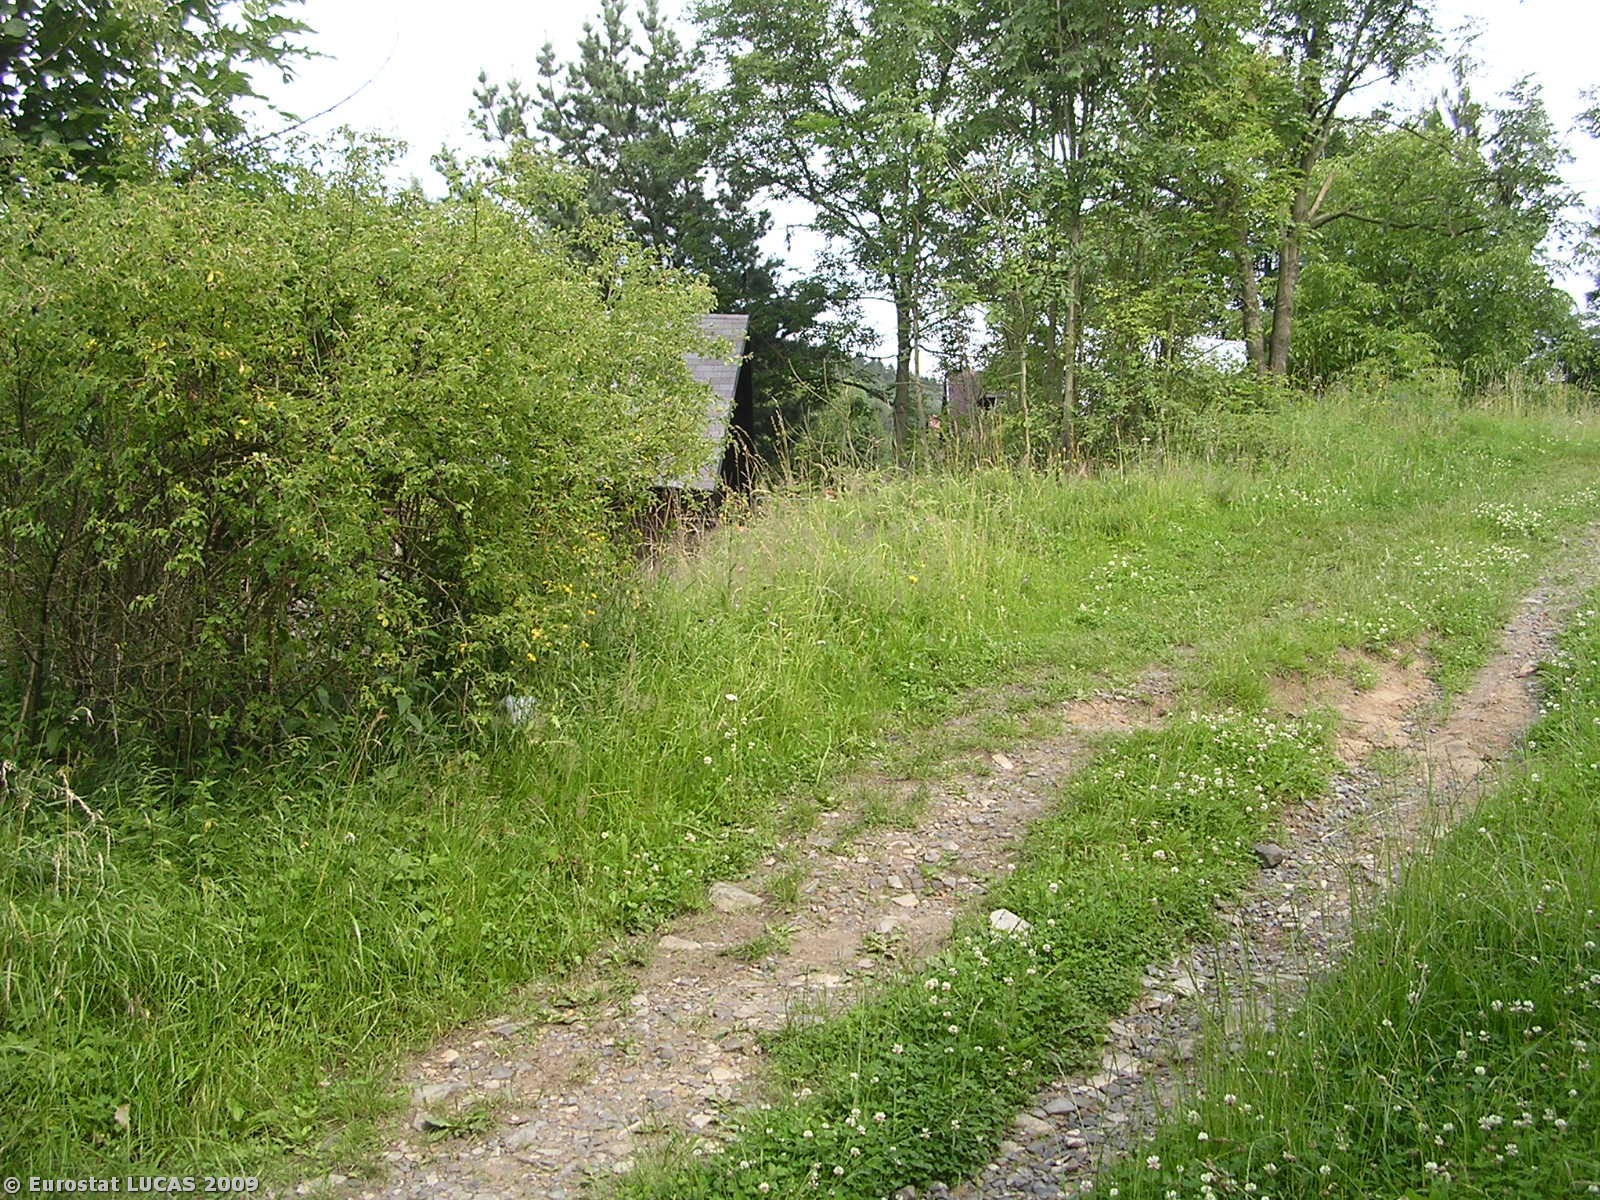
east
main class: Grassland
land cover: Grassland without tree/shrub cover
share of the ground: > 75 %
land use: Unused
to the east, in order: Grassland without tree/shrub cover; Tracks; Grassland with sparse tree/shrub cover; Fences; Artificial constructions in urban areas; Fences; Grass margins; Spontaneously vegetated surfaces; Single bushes/trees; Fences; Grassland without tree/shrub cover; Groves; Fences; Broadleaved woodland; Rivers and streams; Broadleaved woodland
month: July
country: CZ
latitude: 50.7810
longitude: 14.4694
